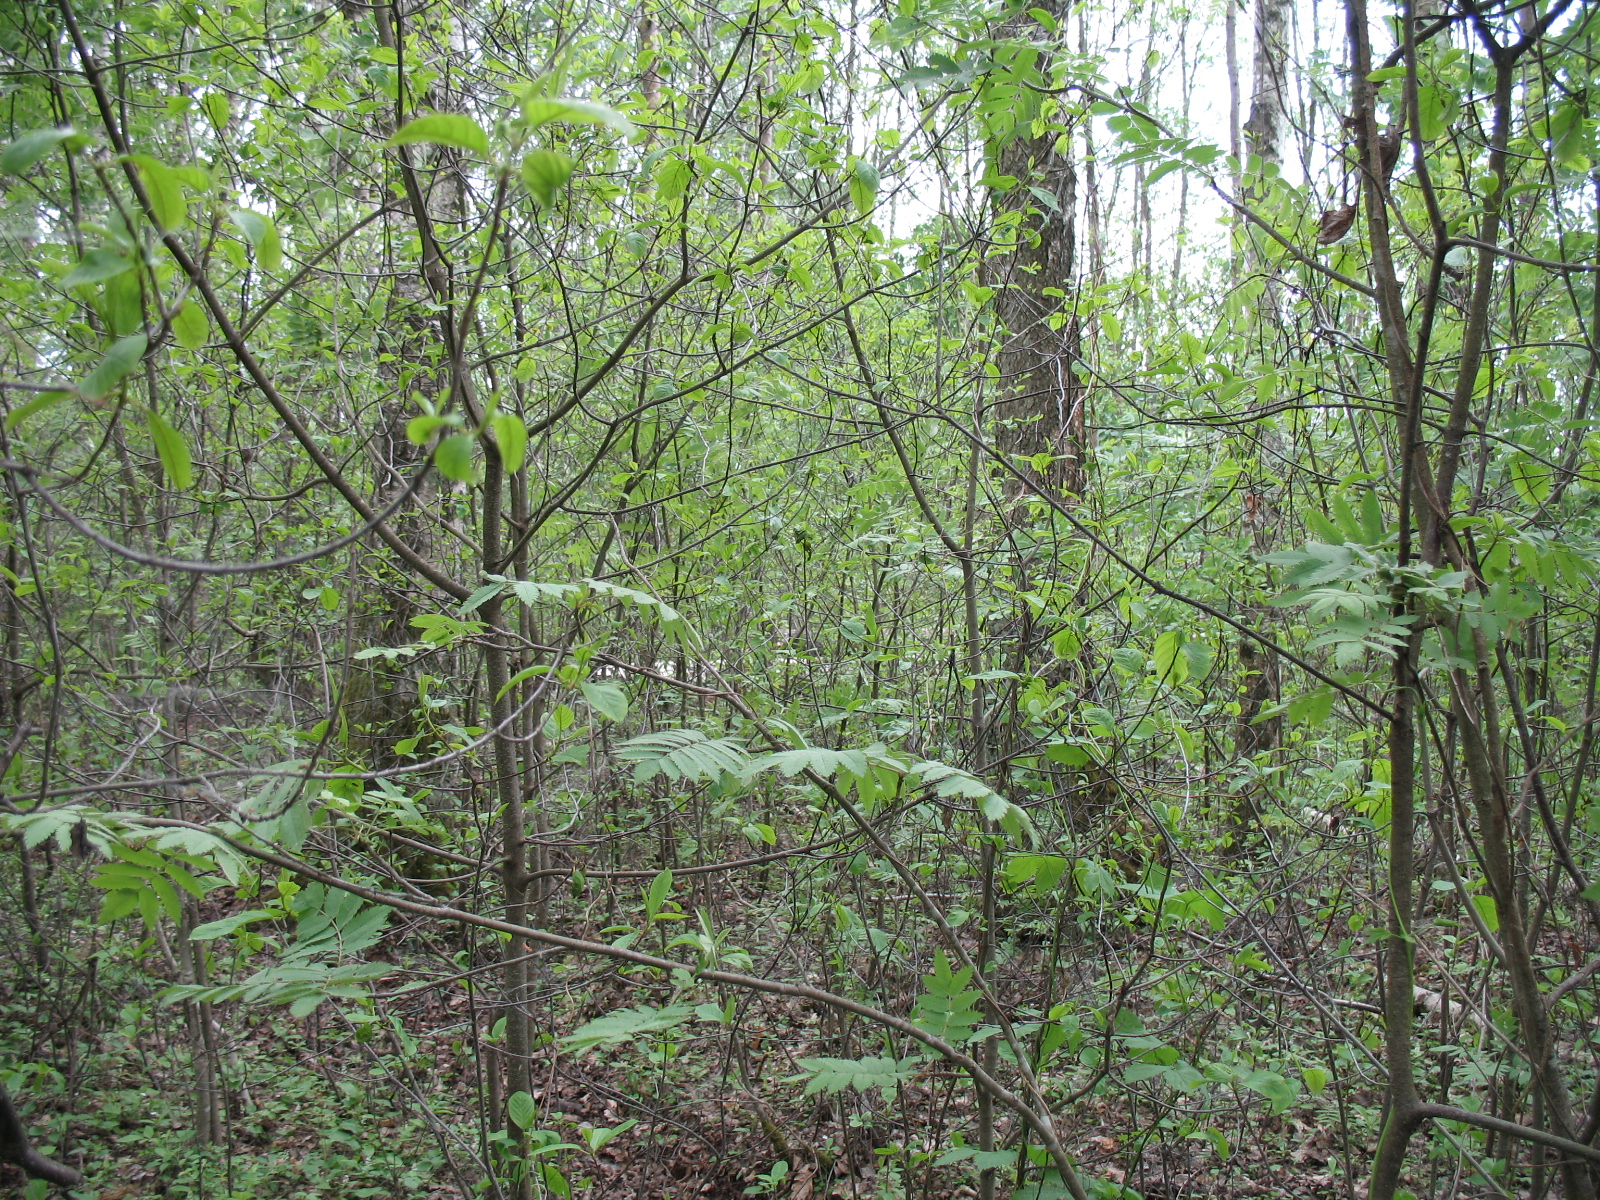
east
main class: Woodland
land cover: Broadleaved woodland
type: non-riverine alder, birch or aspen forest
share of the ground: > 75 %
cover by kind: broadleaved forest trees 95 %, shrubs 5 %
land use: Forestry
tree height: > 5 m
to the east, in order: Broadleaved woodland; Spontaneously vegetated surfaces; Broadleaved woodland; Shrubland with sparse tree cover; Spontaneously vegetated surfaces; Shrubland with sparse tree cover; Ditches and canals; Broadleaved woodland; Inland fresh water bodies
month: May
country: LV
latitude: 56.7803
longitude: 23.5442
